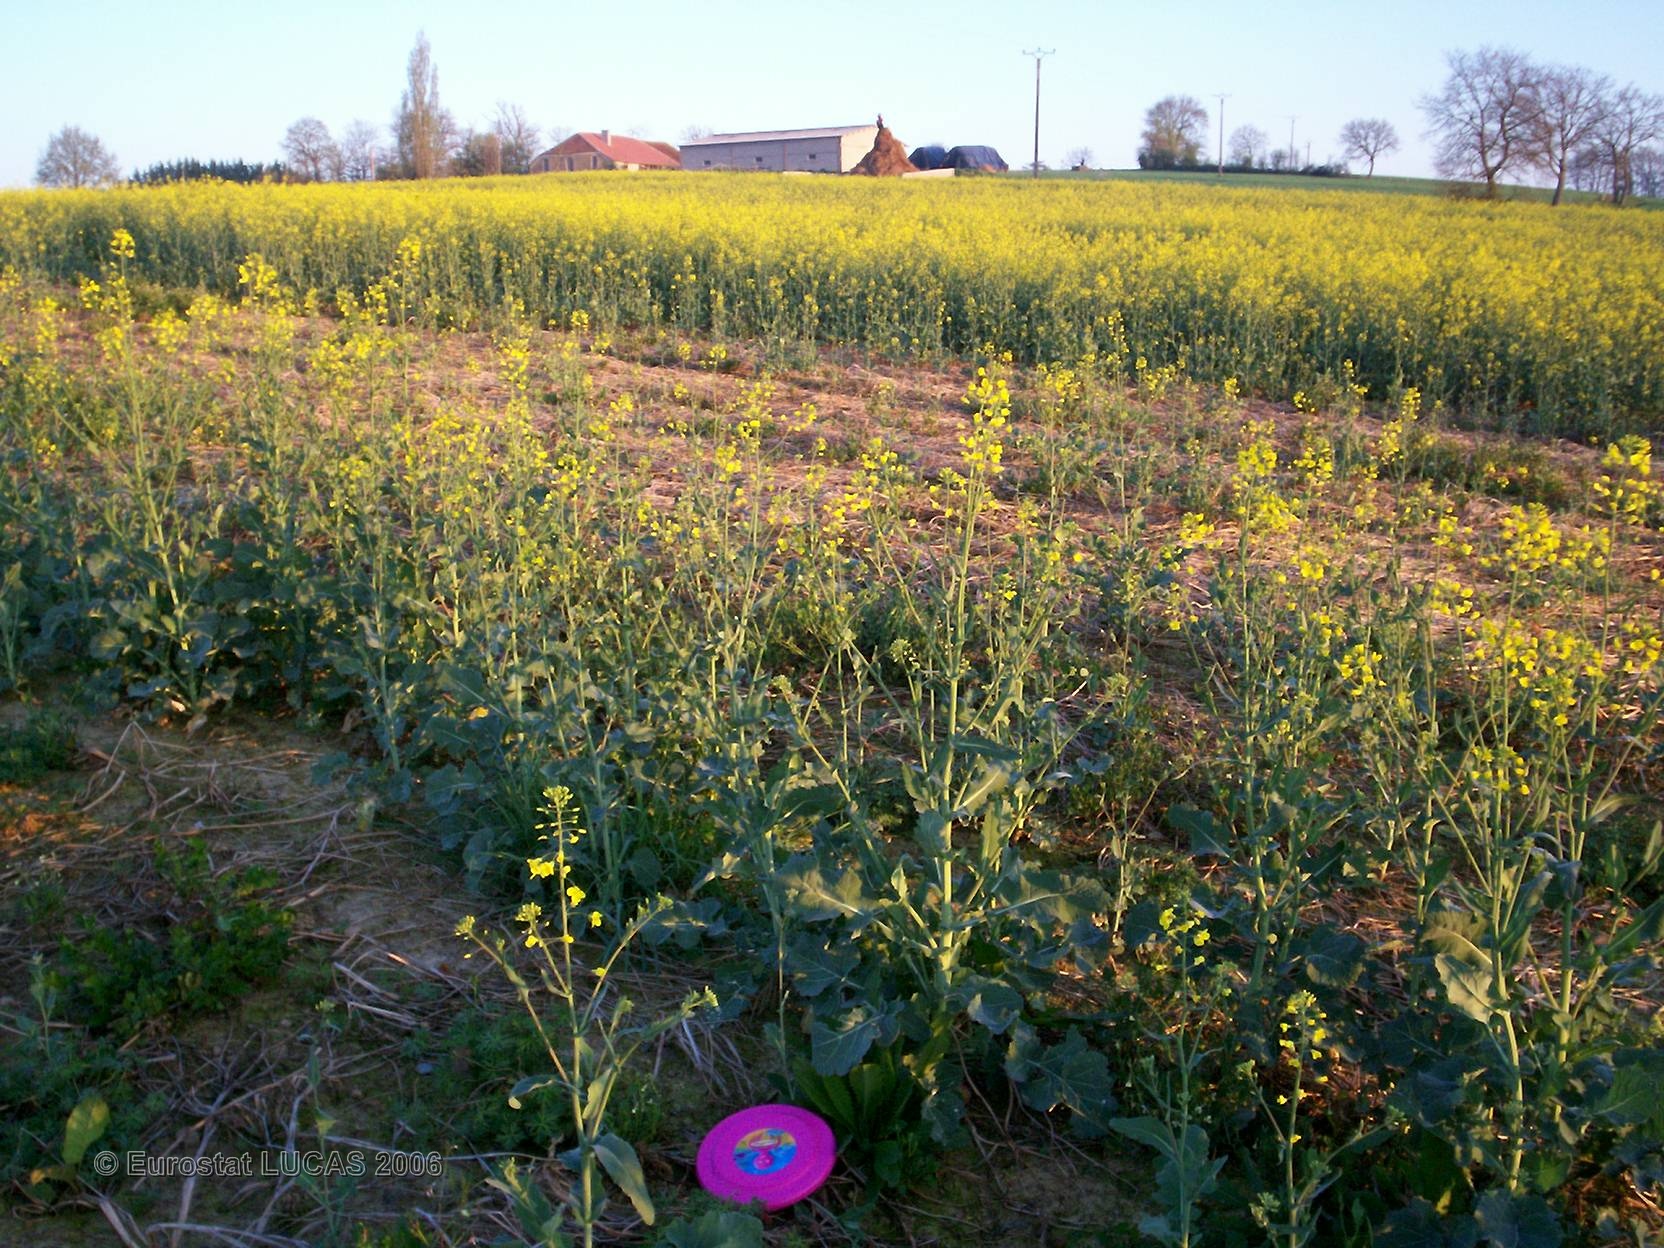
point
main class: Cropland
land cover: Rape and turnip rape
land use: Agriculture (excluding fallow land and kitchen gardens)
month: April
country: FR
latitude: 43.5078
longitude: 0.2371
